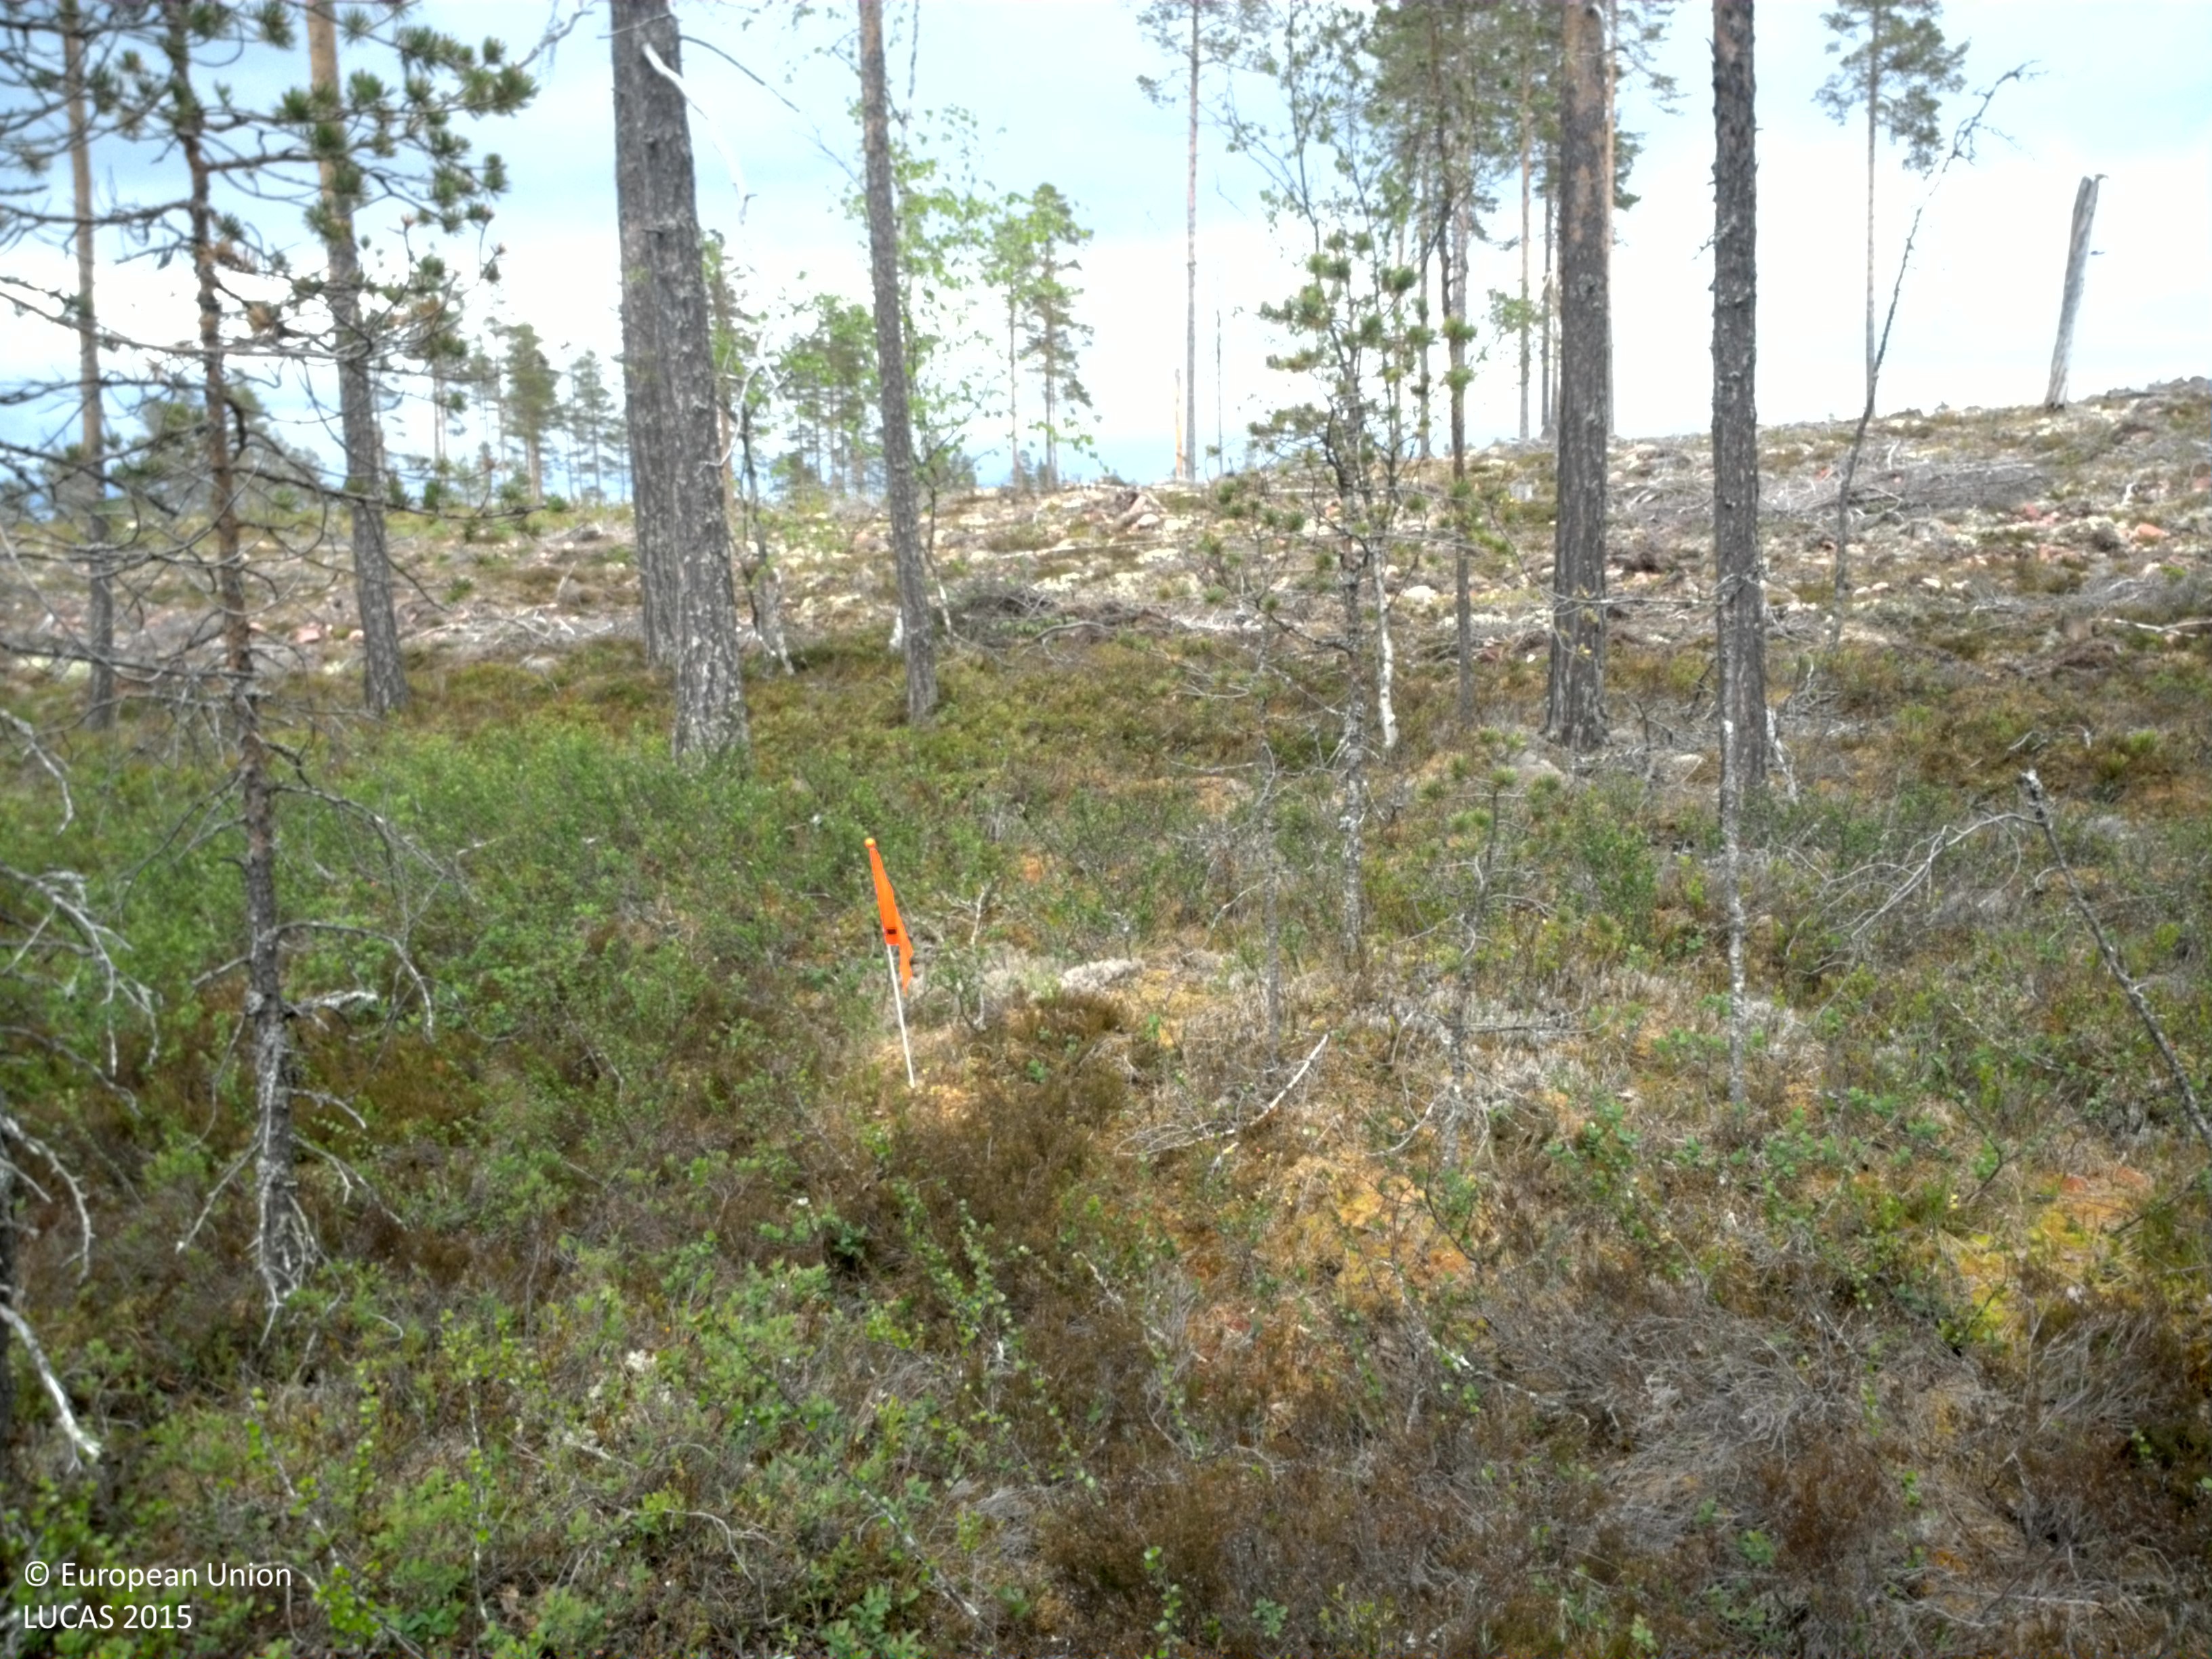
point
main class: Woodland
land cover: Pine dominated coniferous woodland
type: boreal forest
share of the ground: 50 - 75 %
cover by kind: coniferous forest trees 60 %, herbaceous plants 20 %, lichens and mosses 20 %
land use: Forestry
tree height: > 5 m
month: June
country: SE
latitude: 61.3067
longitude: 13.5911
